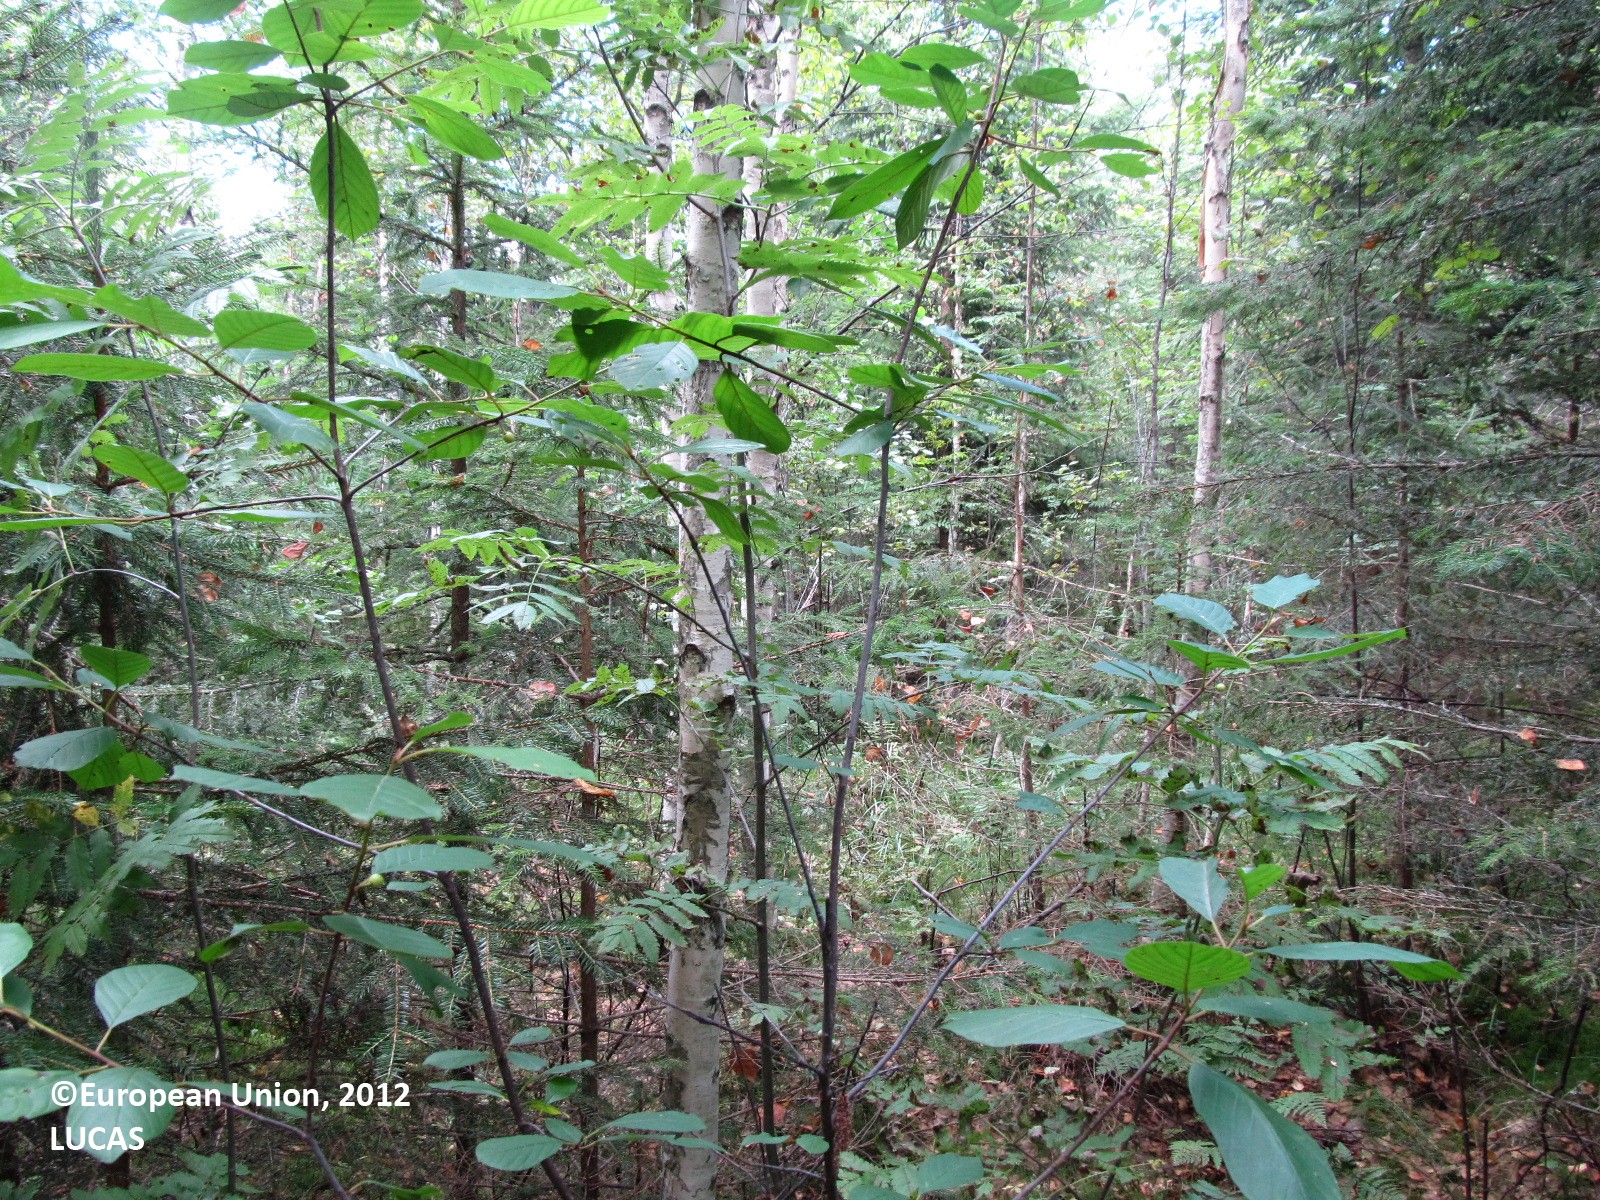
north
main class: Woodland
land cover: Spruce dominated mixed woodland
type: boreal forest
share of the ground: 50 - 75 %
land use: Forestry
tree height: > 5 m
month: August
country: FI
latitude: 61.8186
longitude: 27.7790
